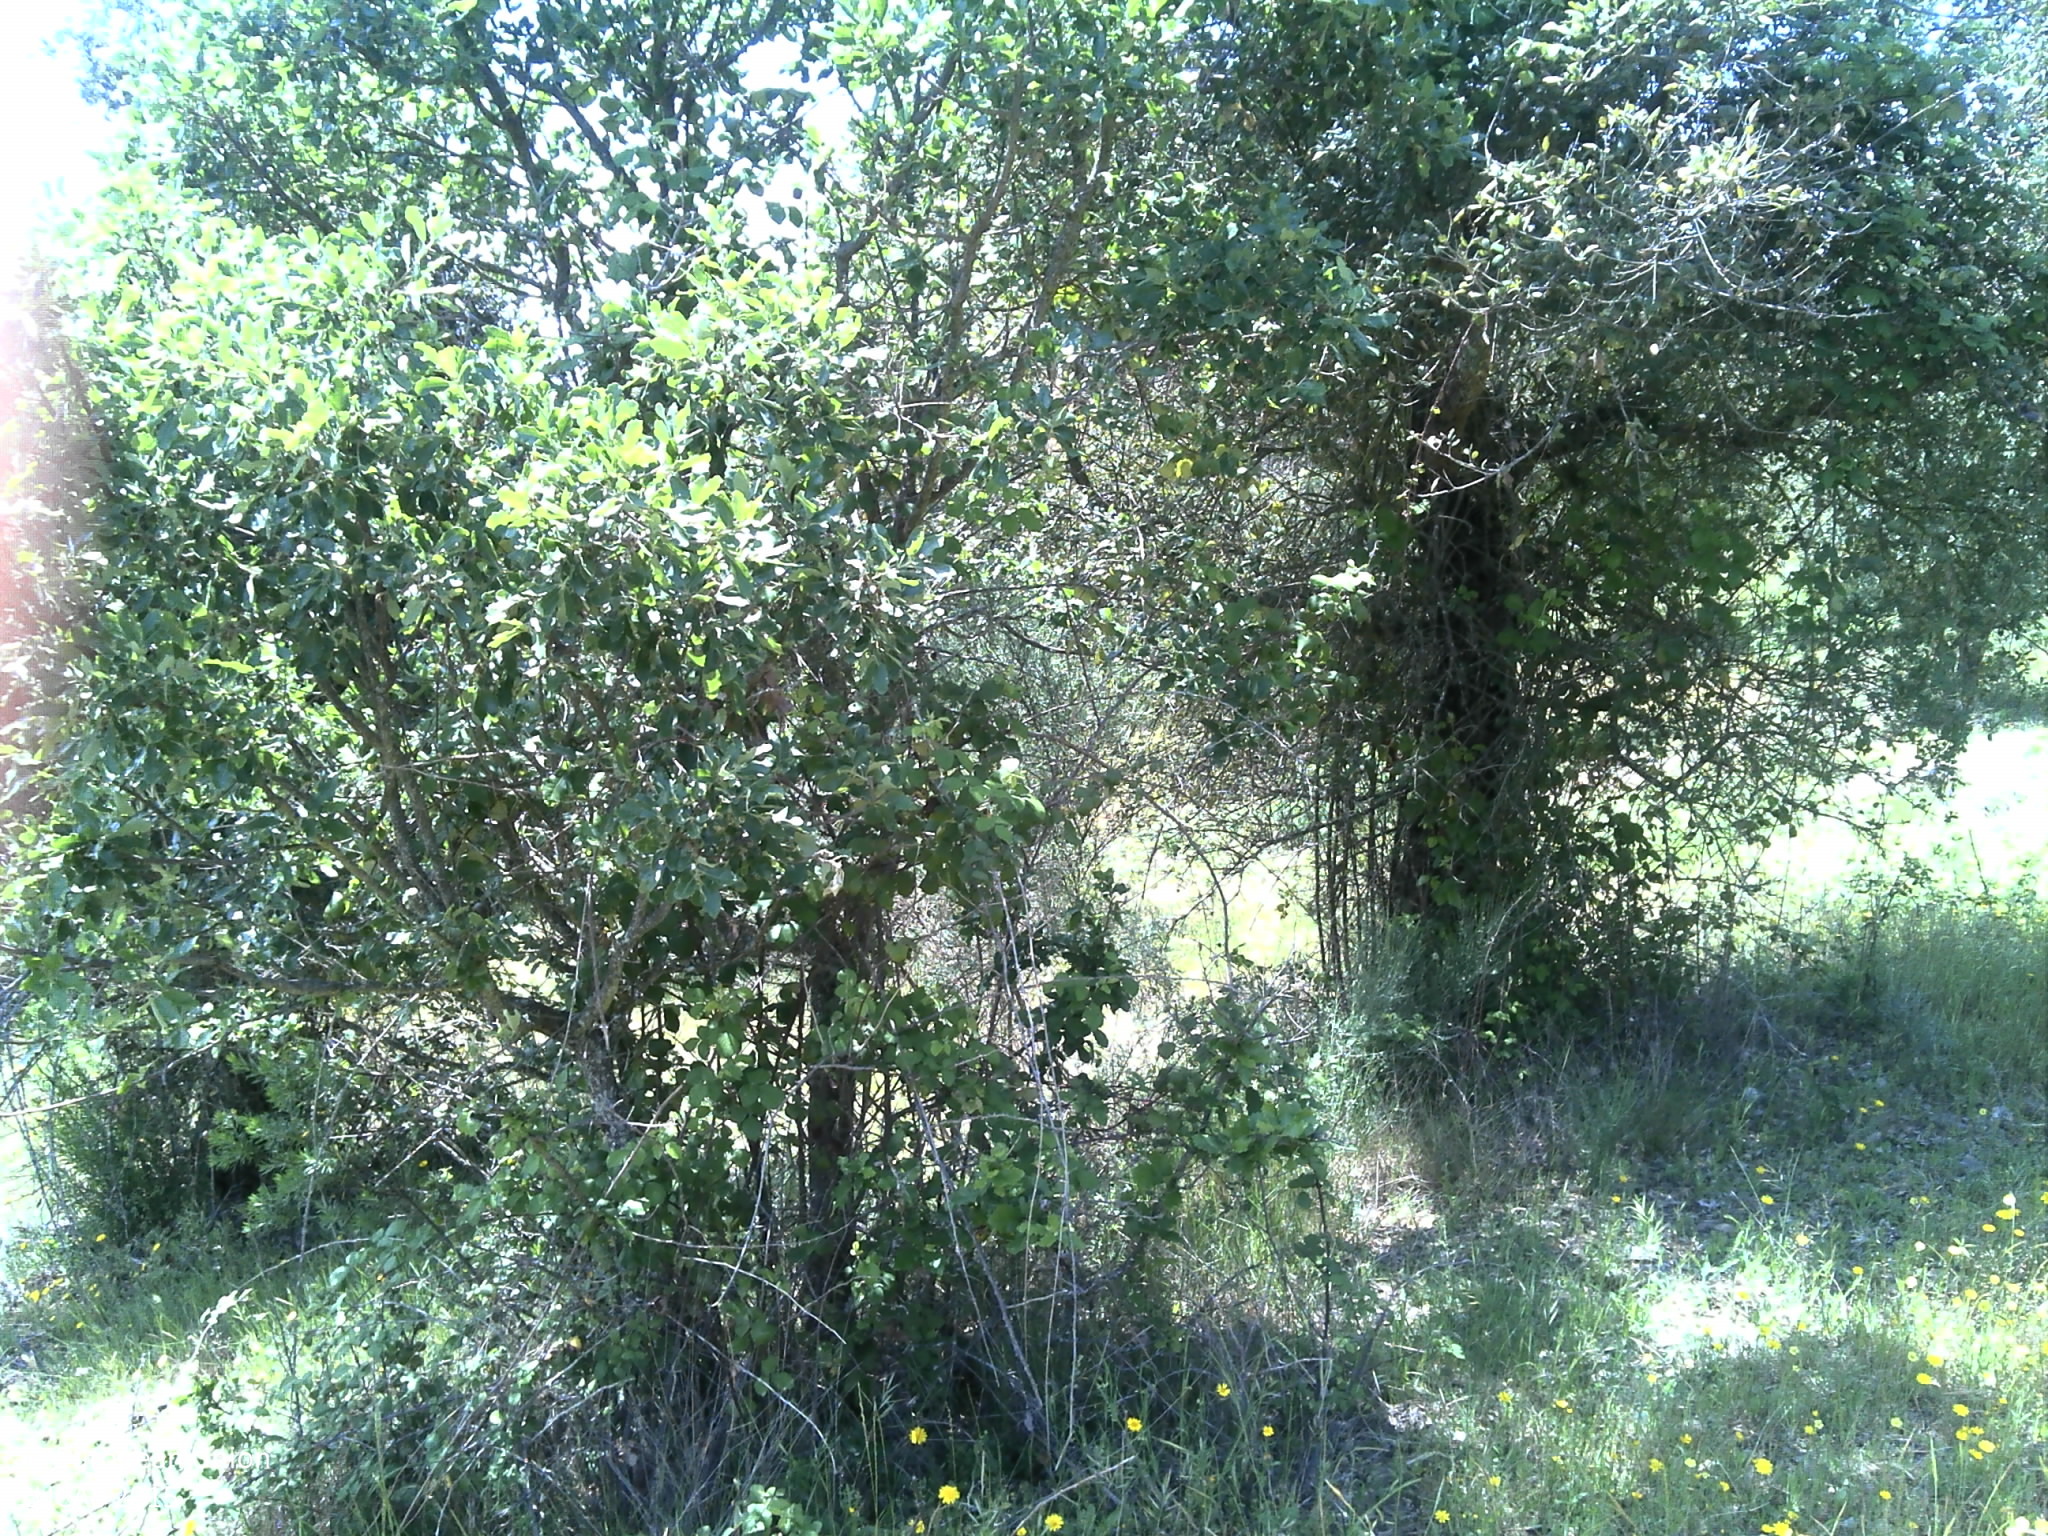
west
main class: Woodland
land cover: Broadleaved woodland
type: broadleaved evergreen forest
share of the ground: 25 - 50 %
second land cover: Spontaneously vegetated surfaces
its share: 50 - 75 %
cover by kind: herbaceous plants 50 %, broadleaved forest trees 40 %, consolidated bare surface 5 %, unconsolidated bare surface 5 %
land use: Forestry
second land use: Agriculture (excluding fallow land and kitchen gardens)
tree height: > 5 m
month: May
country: PT
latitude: 41.5881
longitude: -7.0183
